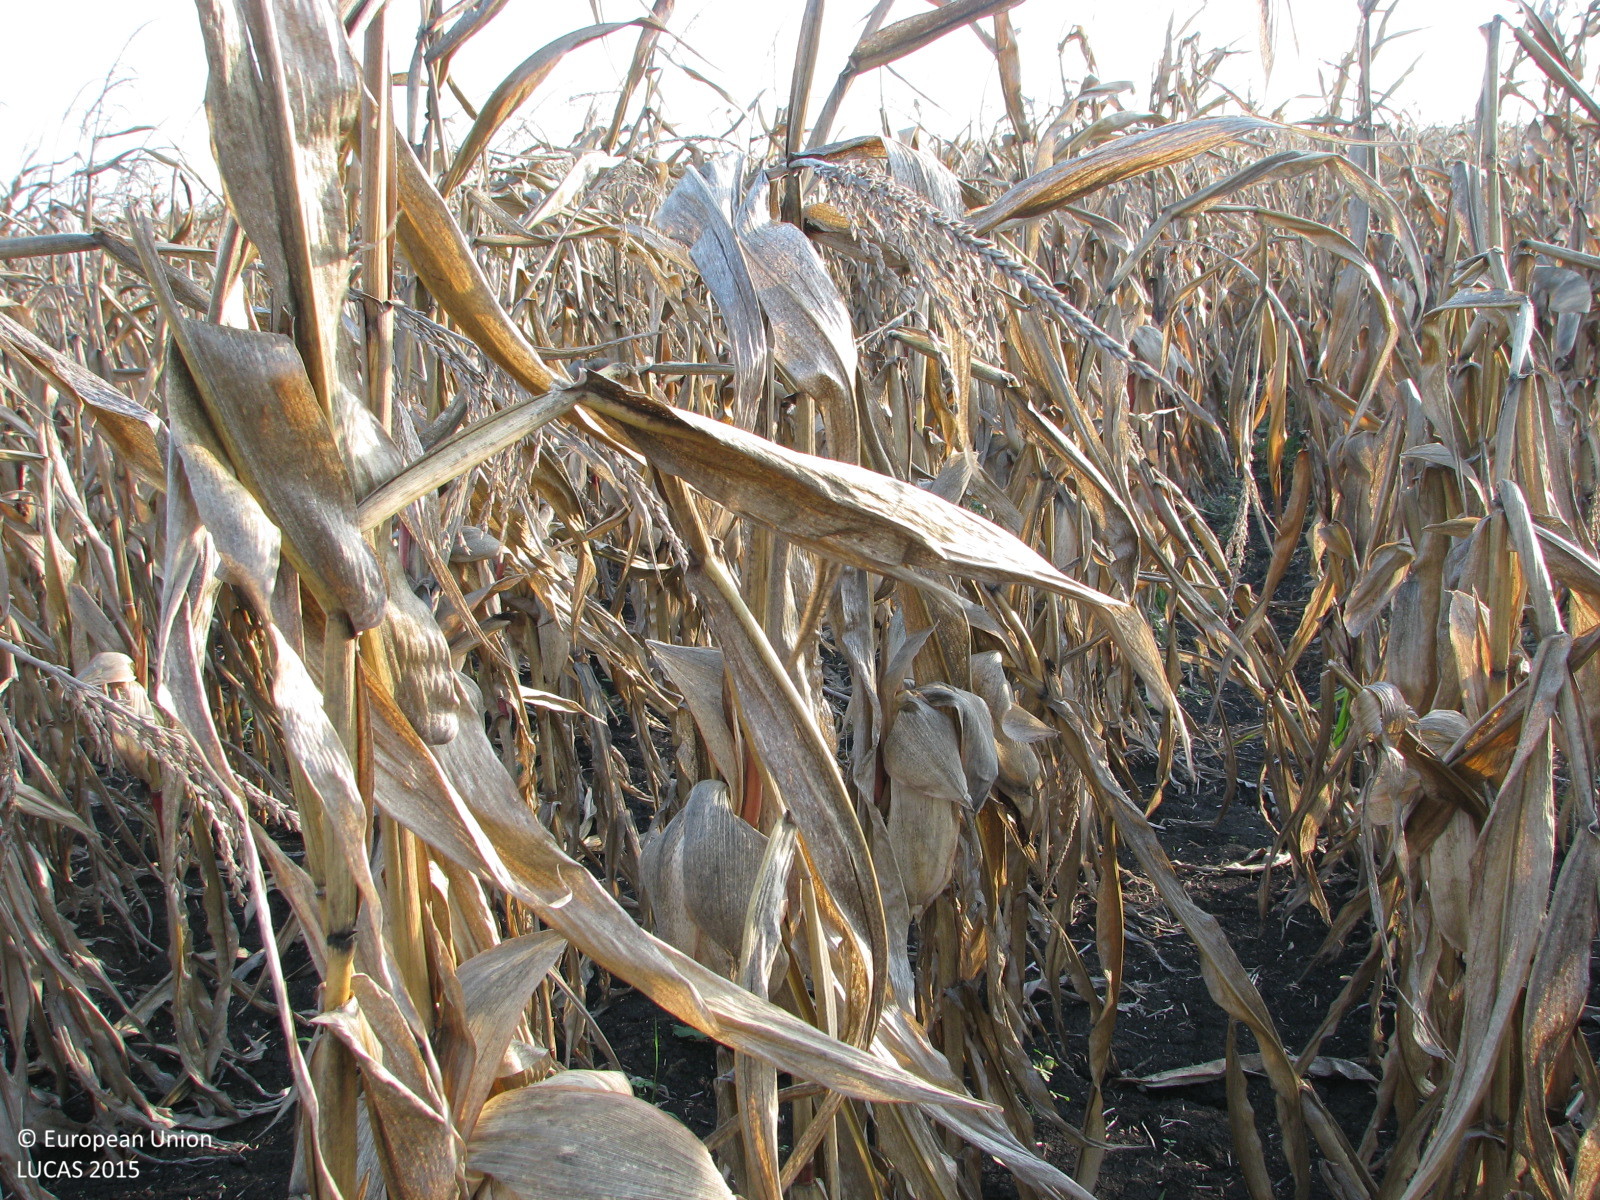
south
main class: Cropland
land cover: Maize
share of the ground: > 75 %
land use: Agriculture (excluding fallow land and kitchen gardens)
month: October
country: BG
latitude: 42.3090
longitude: 26.4544
